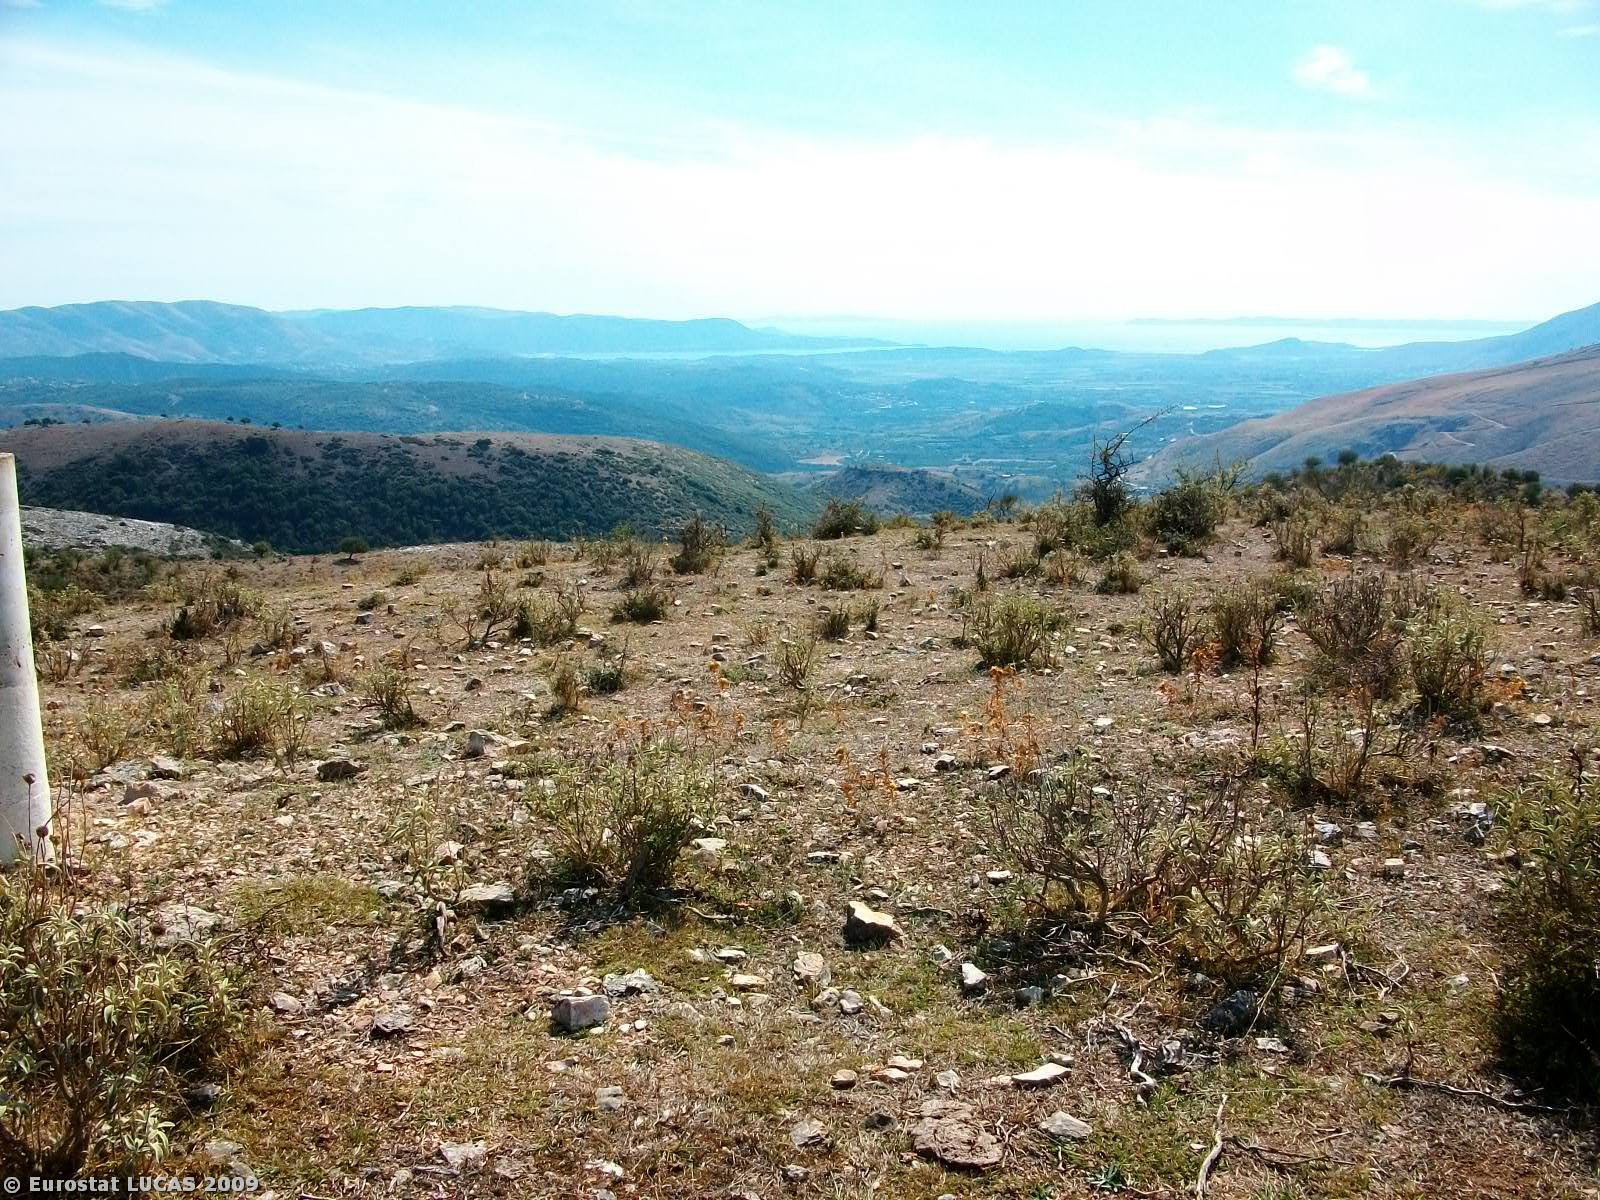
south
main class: Grassland
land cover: Grassland with sparse tree/shrub cover
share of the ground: > 75 %
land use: Agriculture (excluding fallow land and kitchen gardens)
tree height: < 5 m
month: September
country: GR
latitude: 39.6365
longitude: 20.2637
